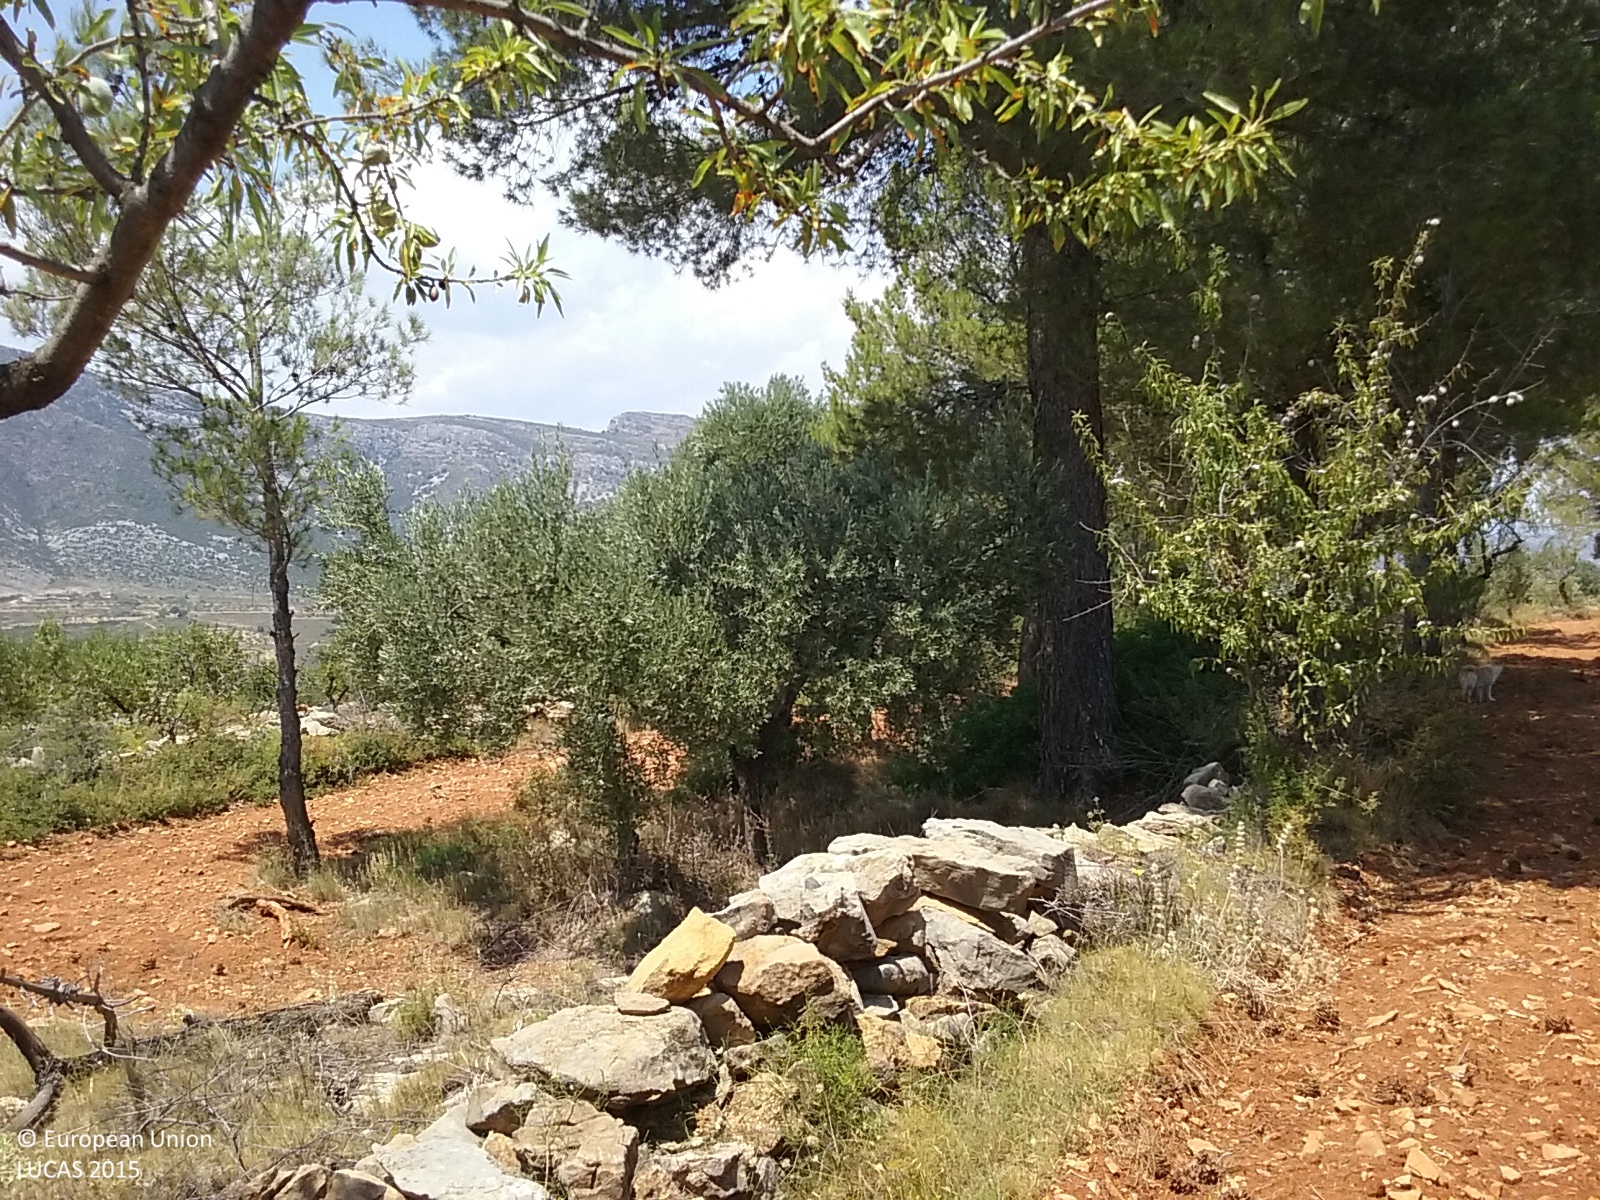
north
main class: Cropland
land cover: Nuts trees
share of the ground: 25 - 50 %
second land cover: Other bare soil
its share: > 75 %
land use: Agriculture (excluding fallow land and kitchen gardens)
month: July
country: ES
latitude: 40.2976
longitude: -0.0391
